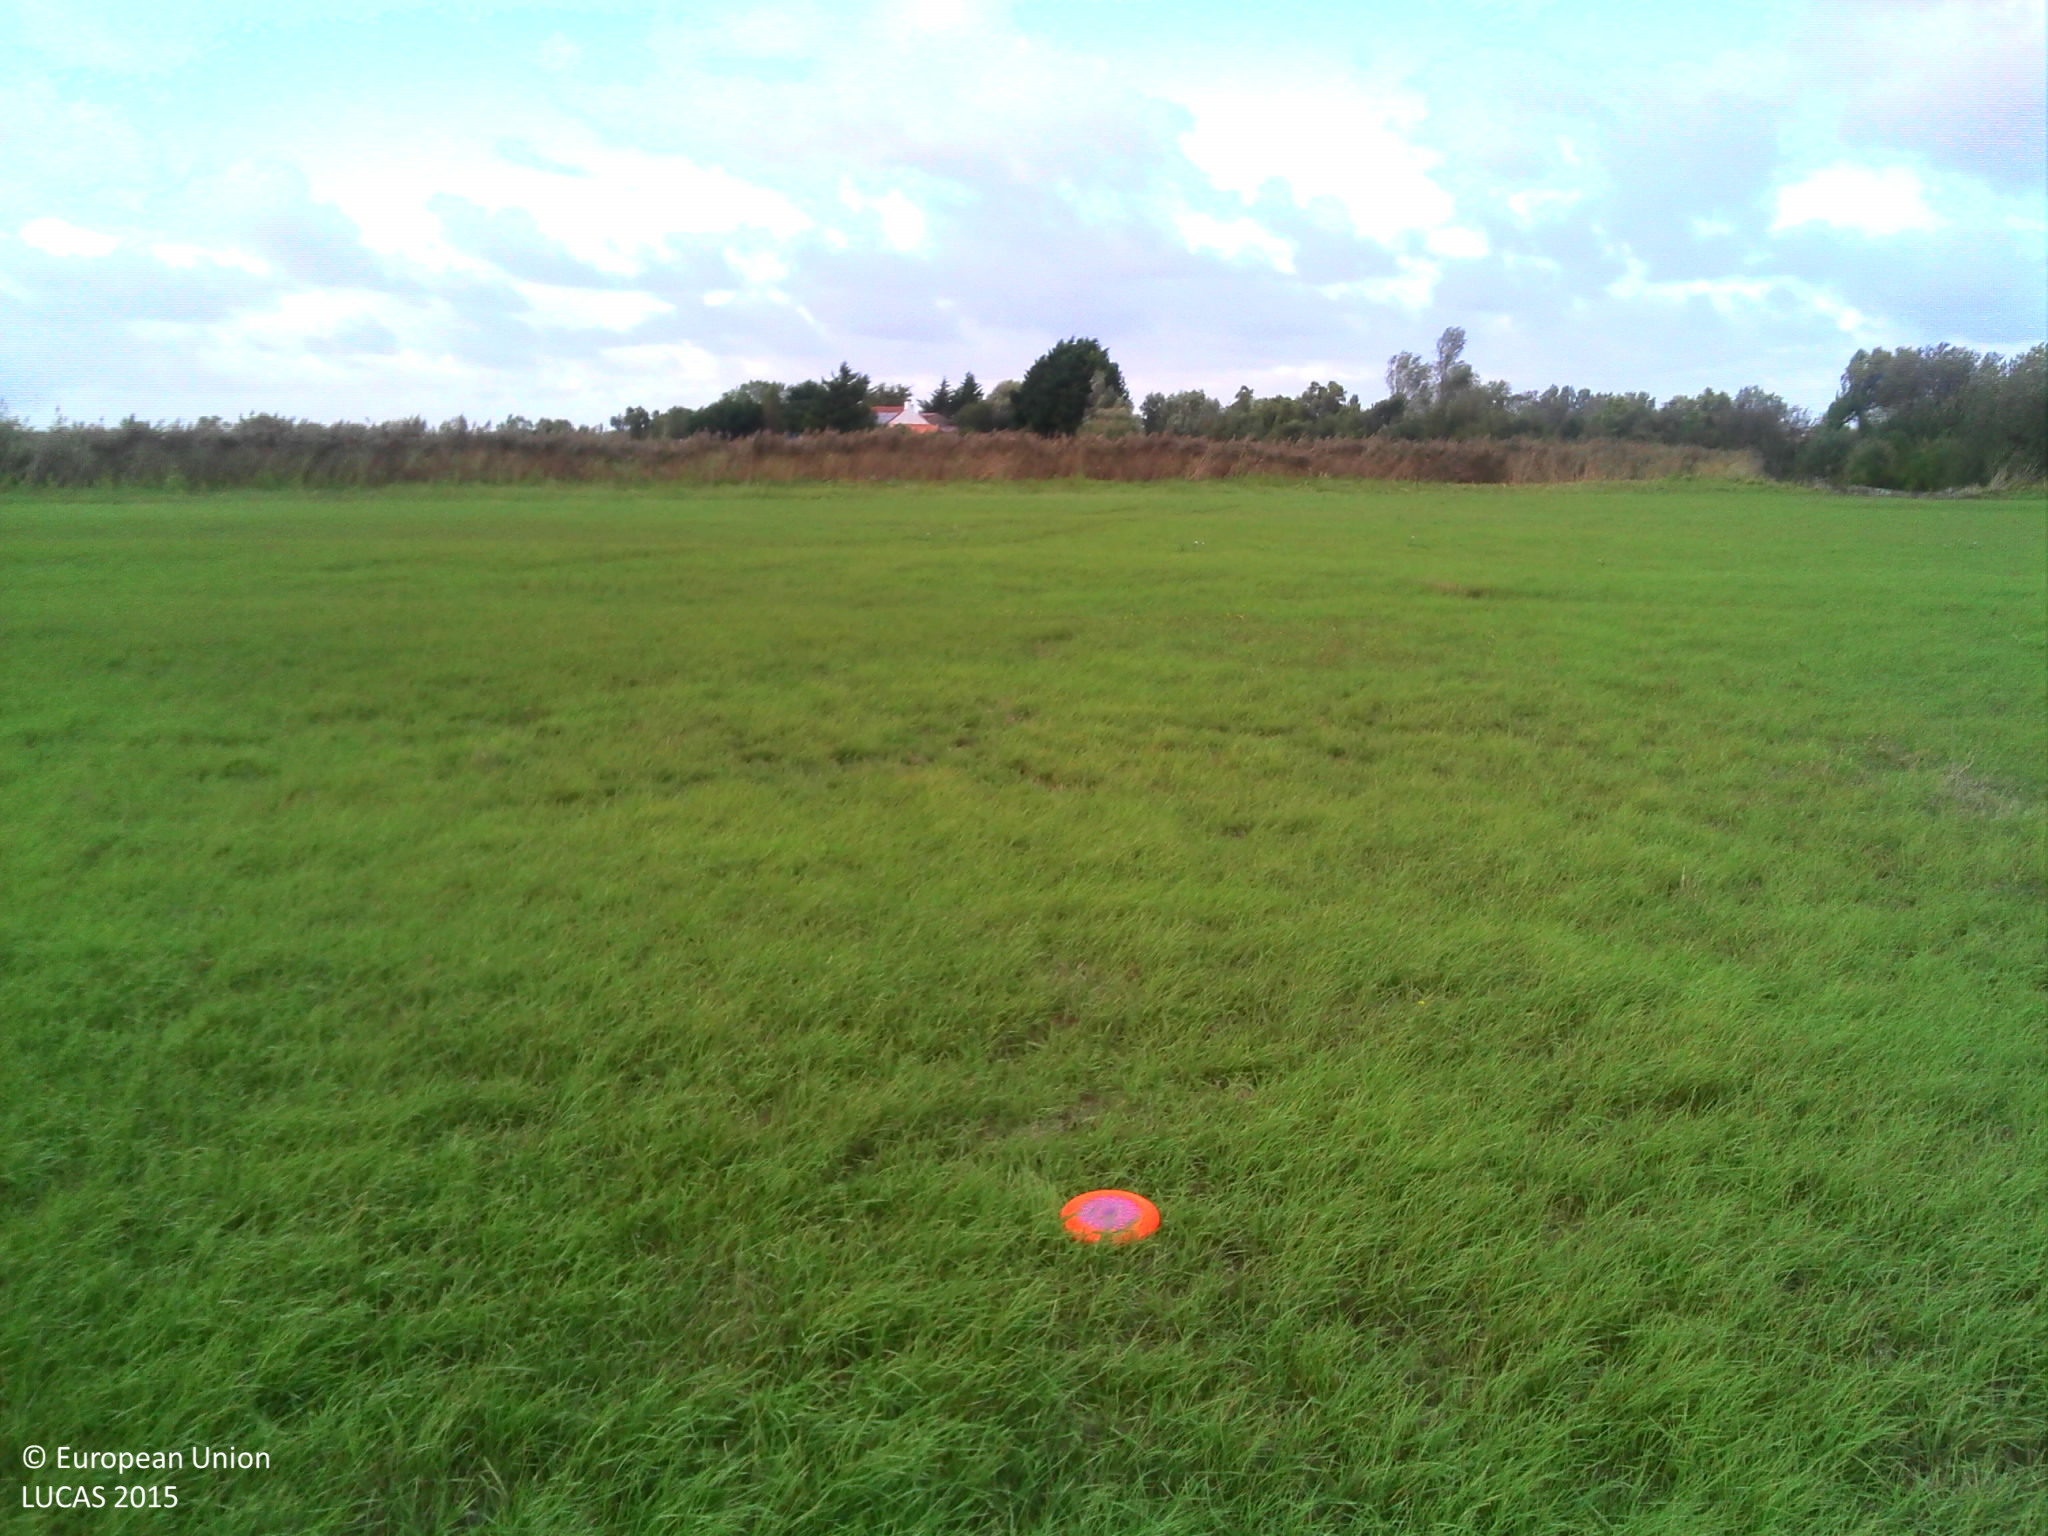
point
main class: Grassland
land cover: Grassland without tree/shrub cover
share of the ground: > 75 %
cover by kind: herbaceous plants 100 %
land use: Agriculture (excluding fallow land and kitchen gardens)
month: September
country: FR
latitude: 46.7557
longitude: -1.9188
